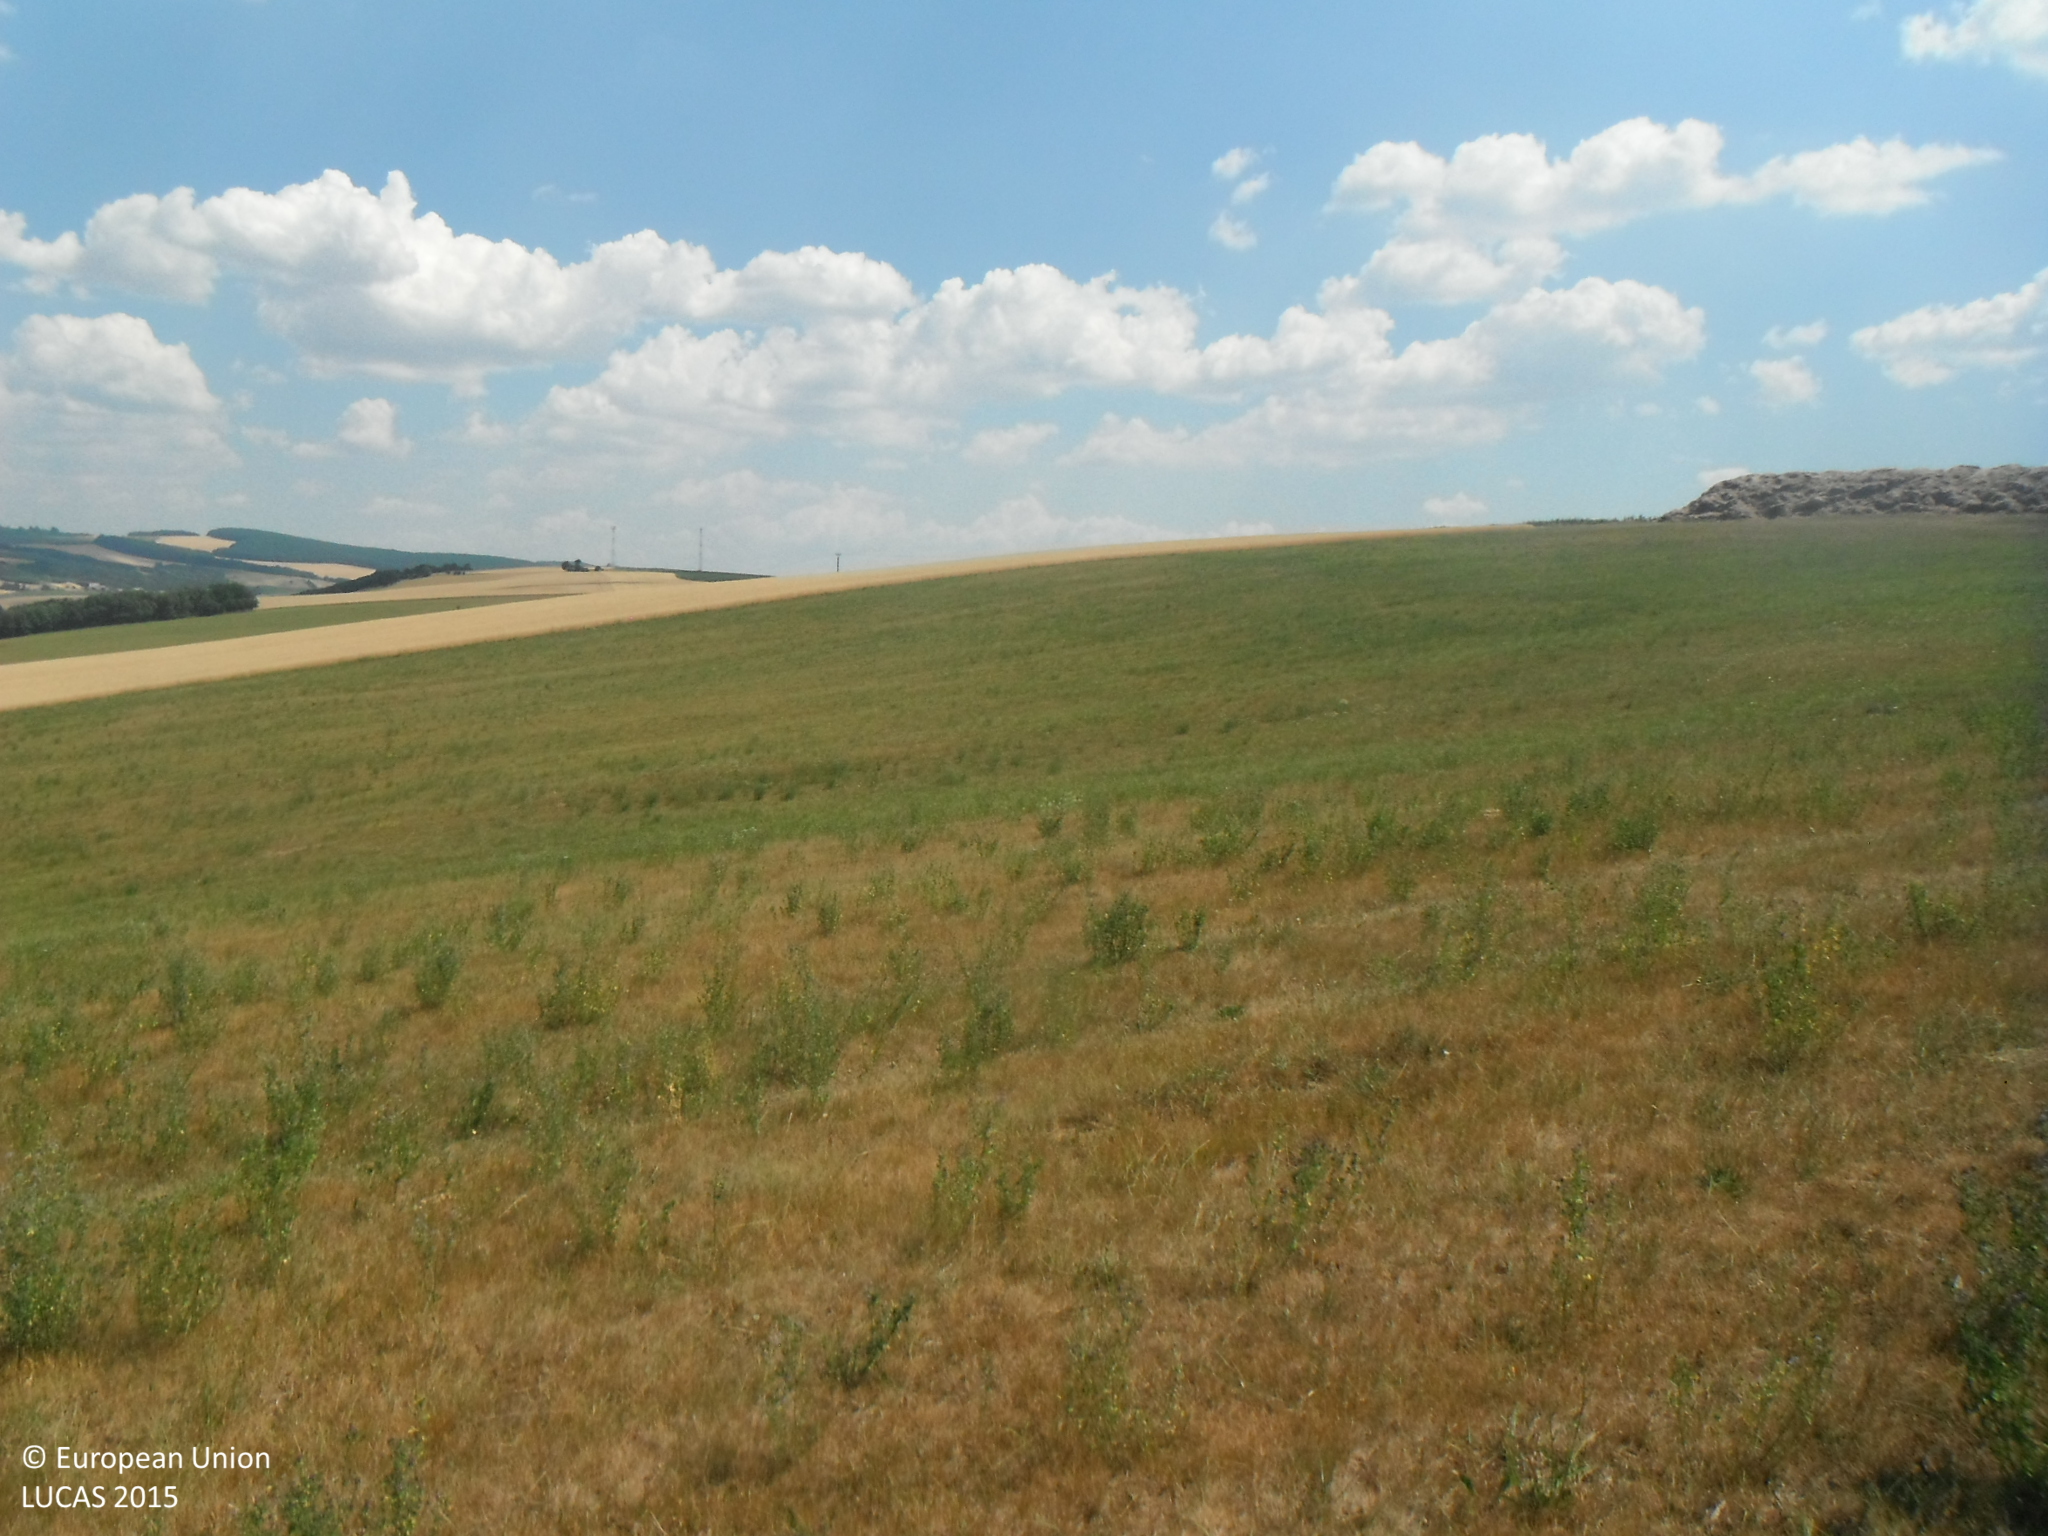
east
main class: Grassland
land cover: Grassland without tree/shrub cover
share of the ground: > 75 %
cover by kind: herbaceous plants 100 %
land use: Agriculture (excluding fallow land and kitchen gardens)
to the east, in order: Grassland without tree/shrub cover; Tracks; Grass margins; Common wheat; Grassland without tree/shrub cover
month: July
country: SK
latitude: 48.7393
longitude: 17.3121
